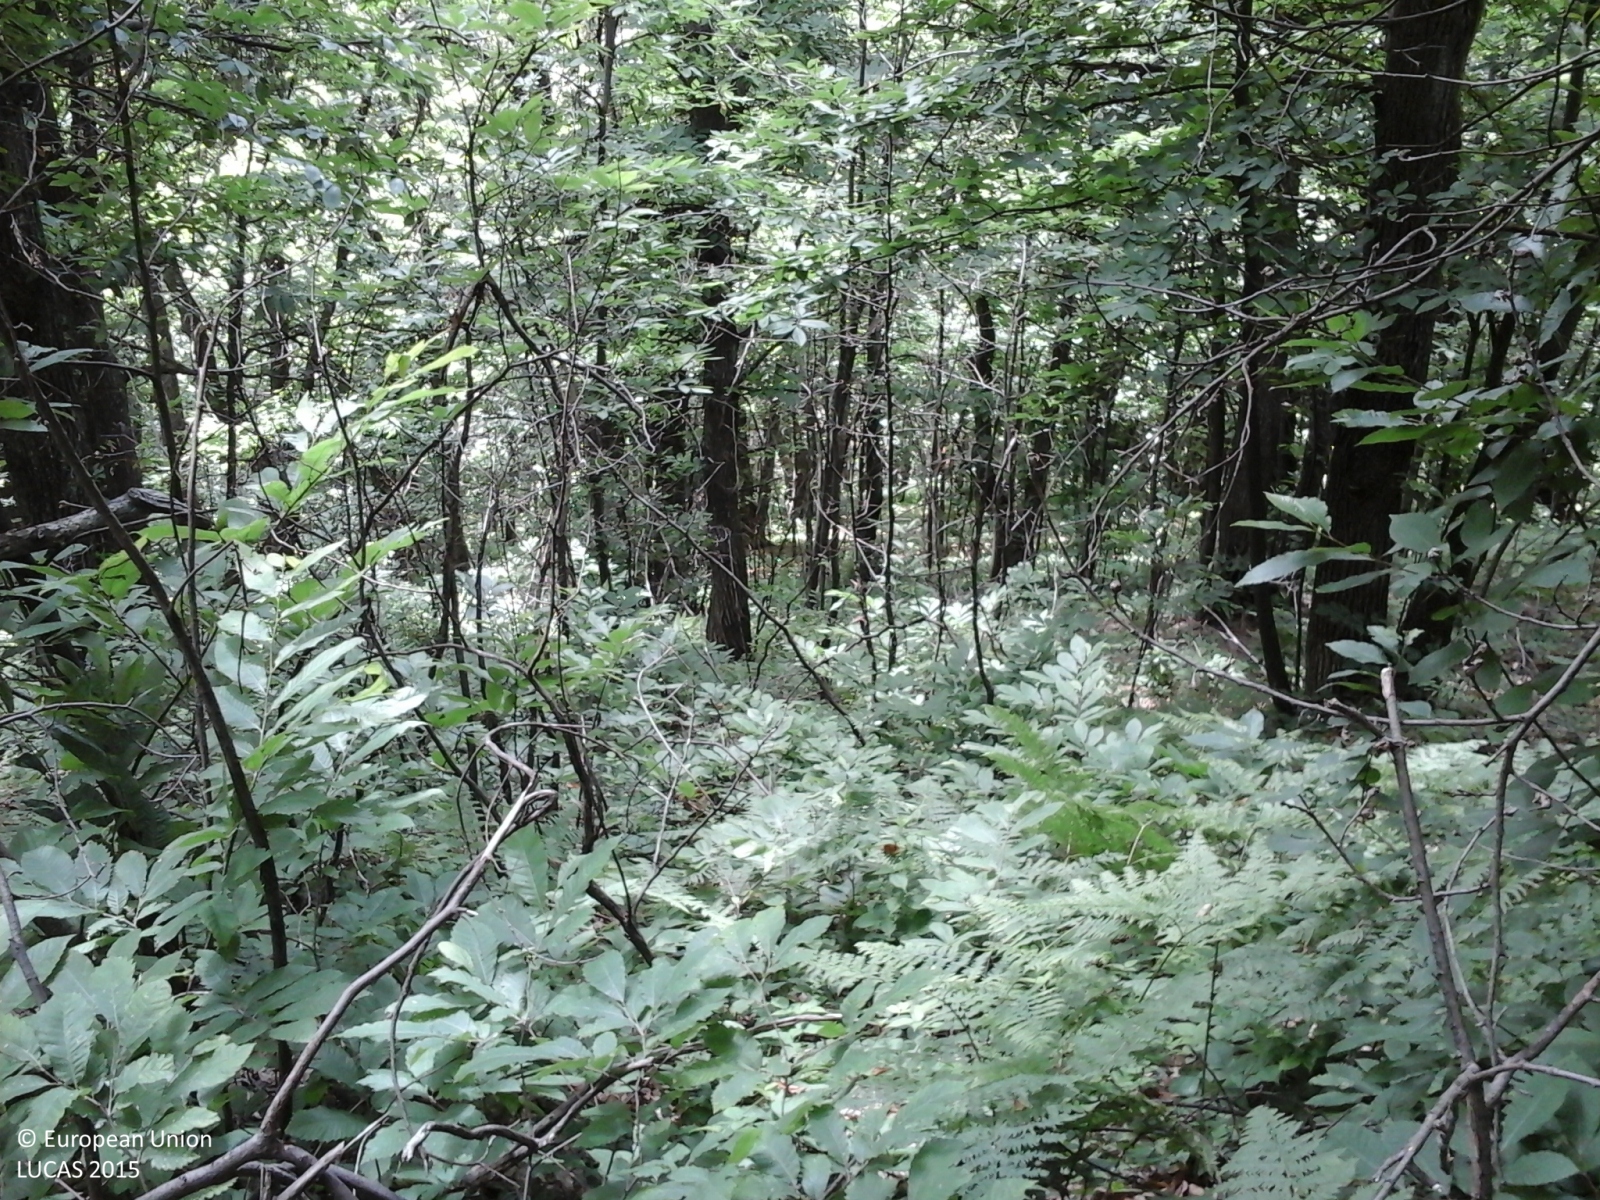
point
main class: Woodland
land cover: Broadleaved woodland
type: thermophilous deciduous forest
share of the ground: > 75 %
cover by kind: broadleaved forest trees 100 %
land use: Forestry
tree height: > 5 m
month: June
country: IT
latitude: 44.2914
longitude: 7.8116
